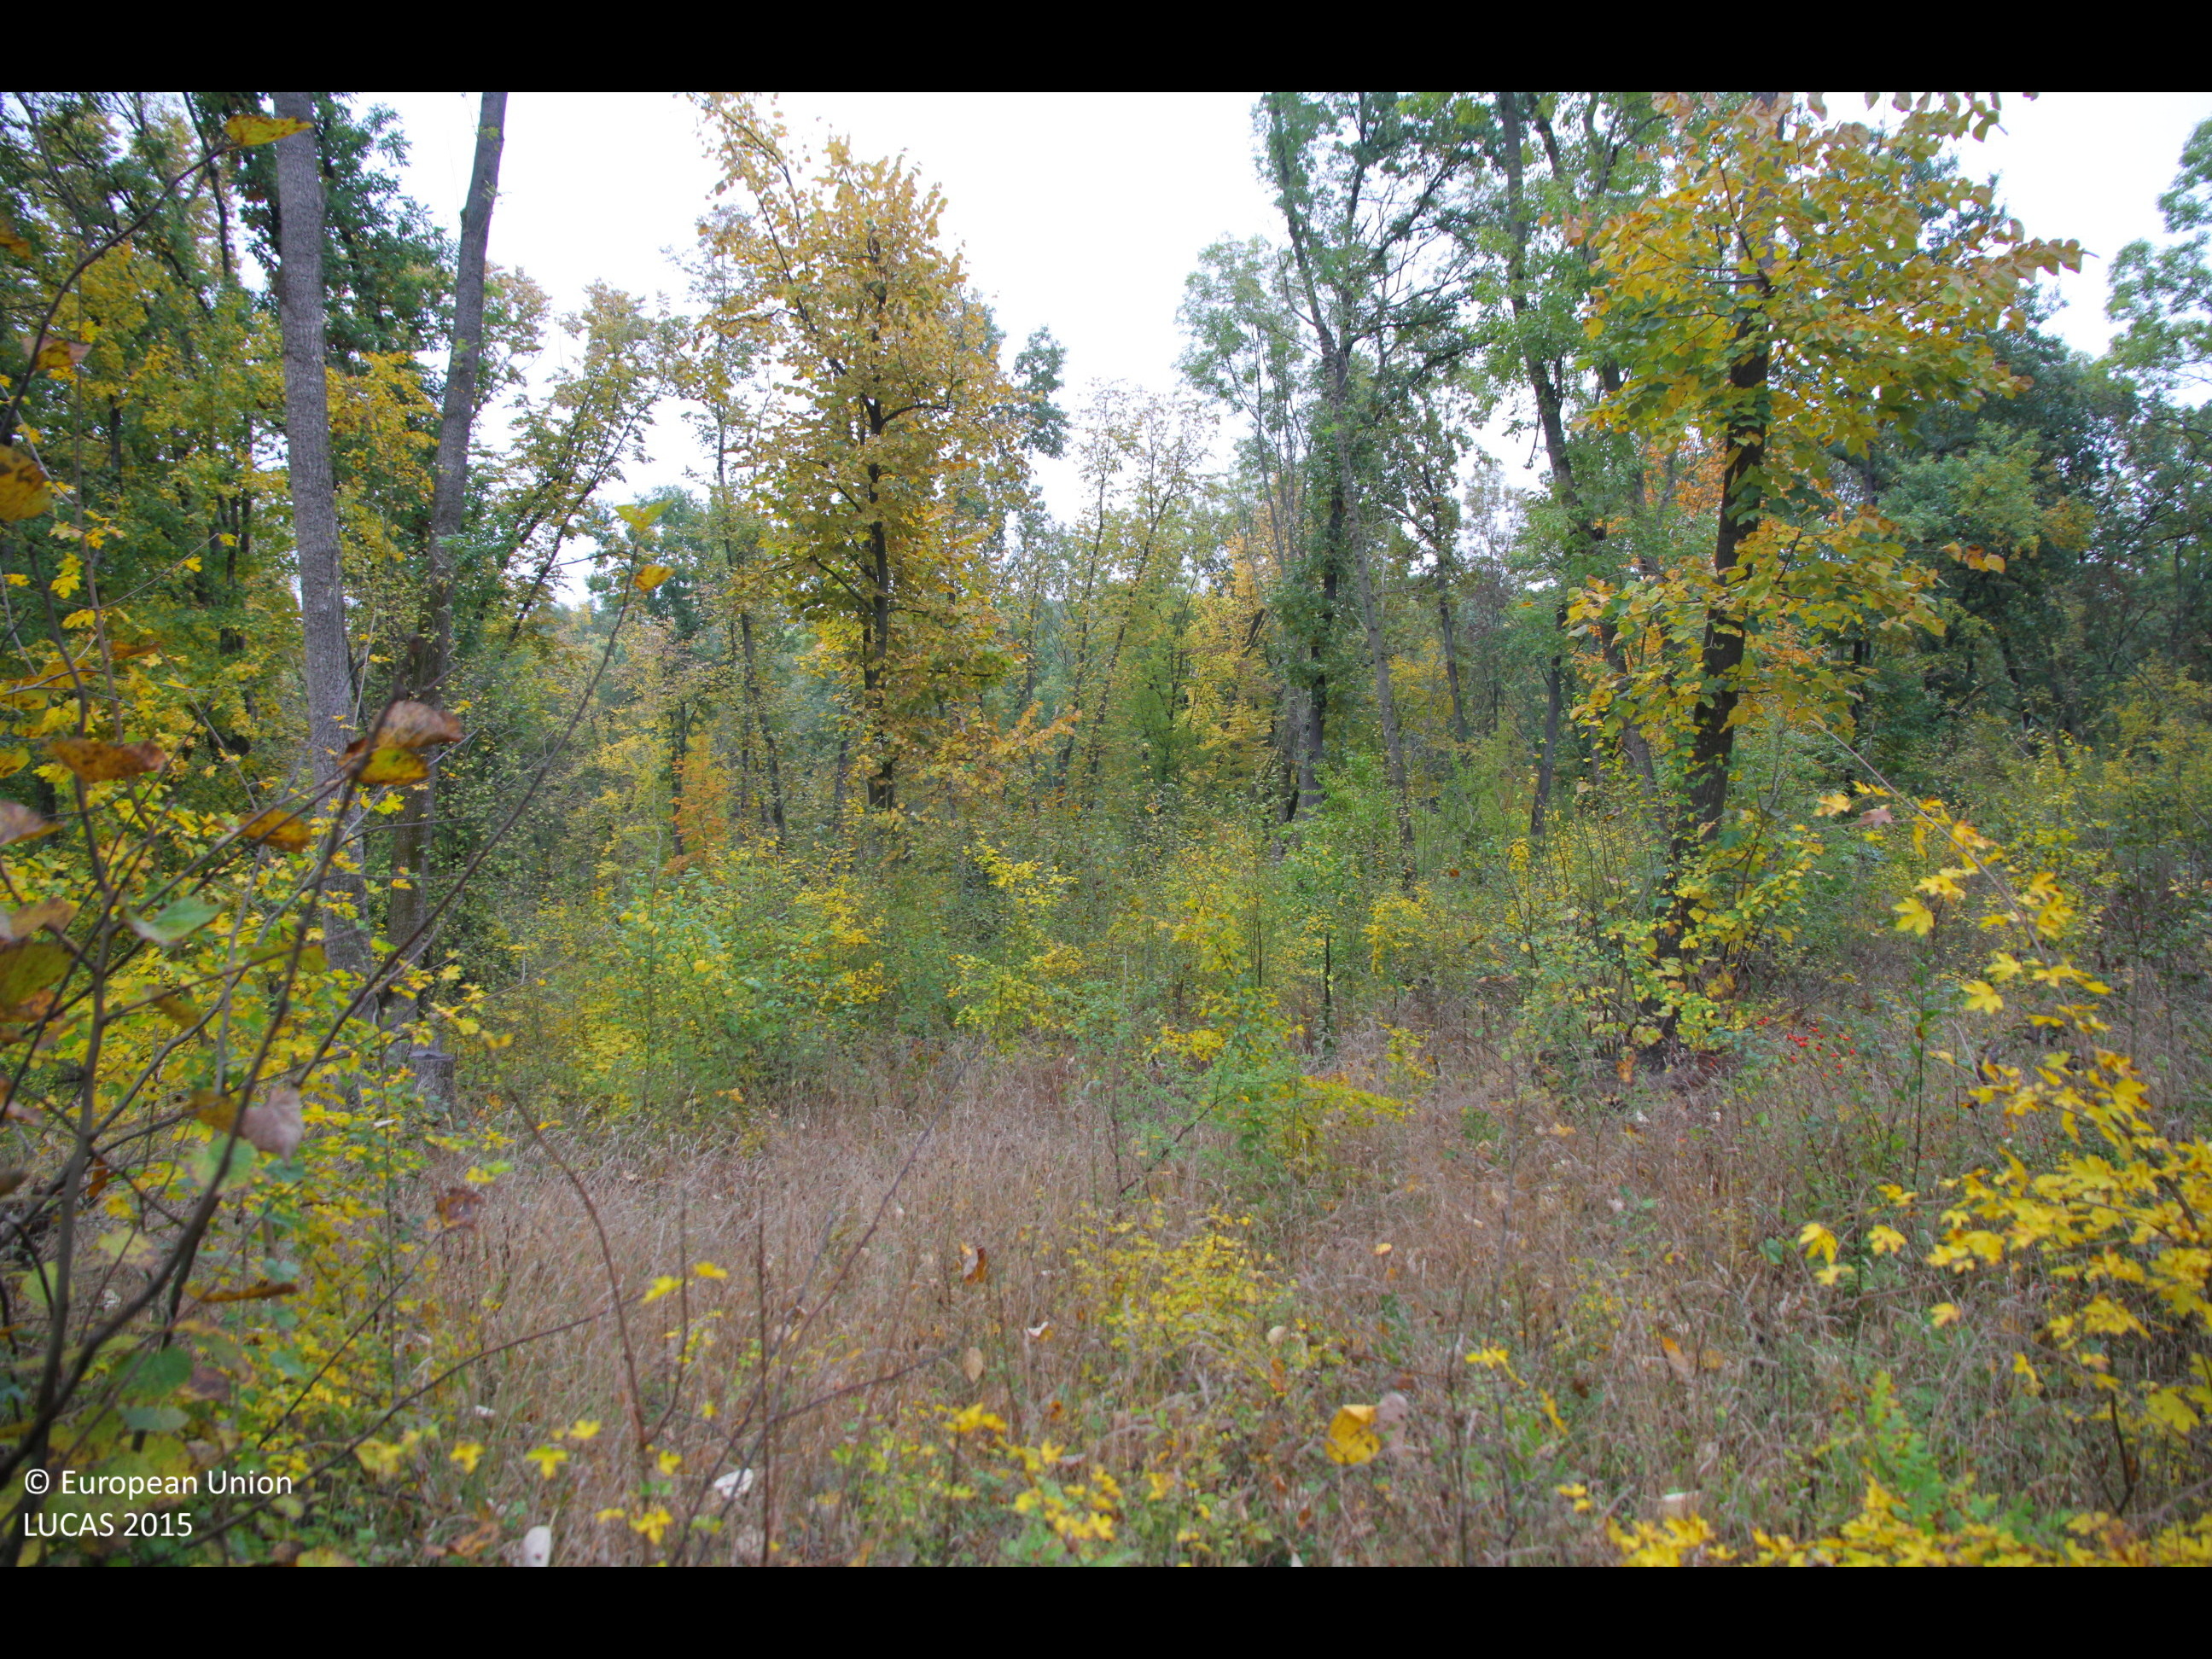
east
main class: Woodland
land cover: Broadleaved woodland
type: mesophytic deciduous forest
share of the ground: 50 - 75 %
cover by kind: broadleaved forest trees 70 %, herbaceous plants 20 %, shrubs 10 %
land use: Forestry
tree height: > 5 m
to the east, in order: Broadleaved woodland; Tracks; Broadleaved woodland; Tracks; Broadleaved woodland; Ditches and canals; Broadleaved woodland; Common wheat
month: October
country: BG
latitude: 43.7980
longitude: 26.6802
